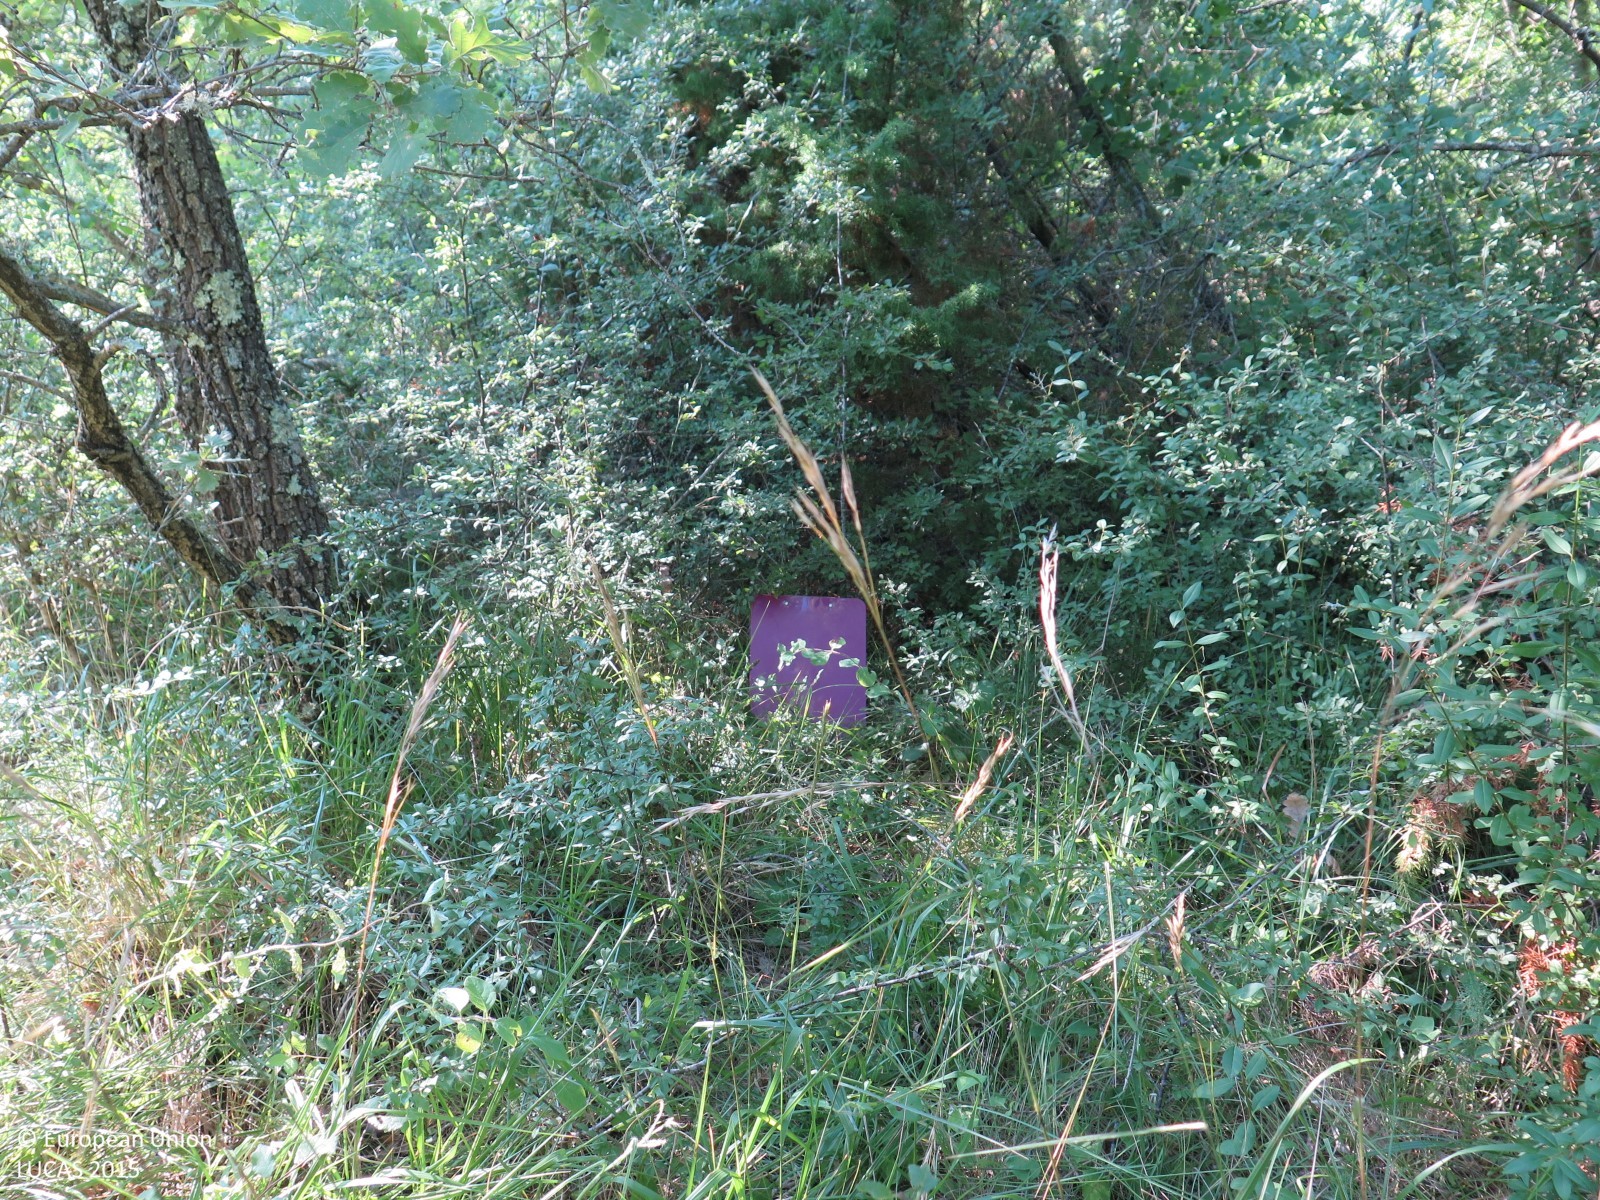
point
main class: Shrubland
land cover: Shrubland with sparse tree cover
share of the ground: > 75 %
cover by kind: shrubs 90 %, broadleaved forest trees 5 %, herbaceous plants 5 %
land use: Semi-natural and natural areas not in use
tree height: > 5 m
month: July
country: HR
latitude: 45.2375
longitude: 13.8037
